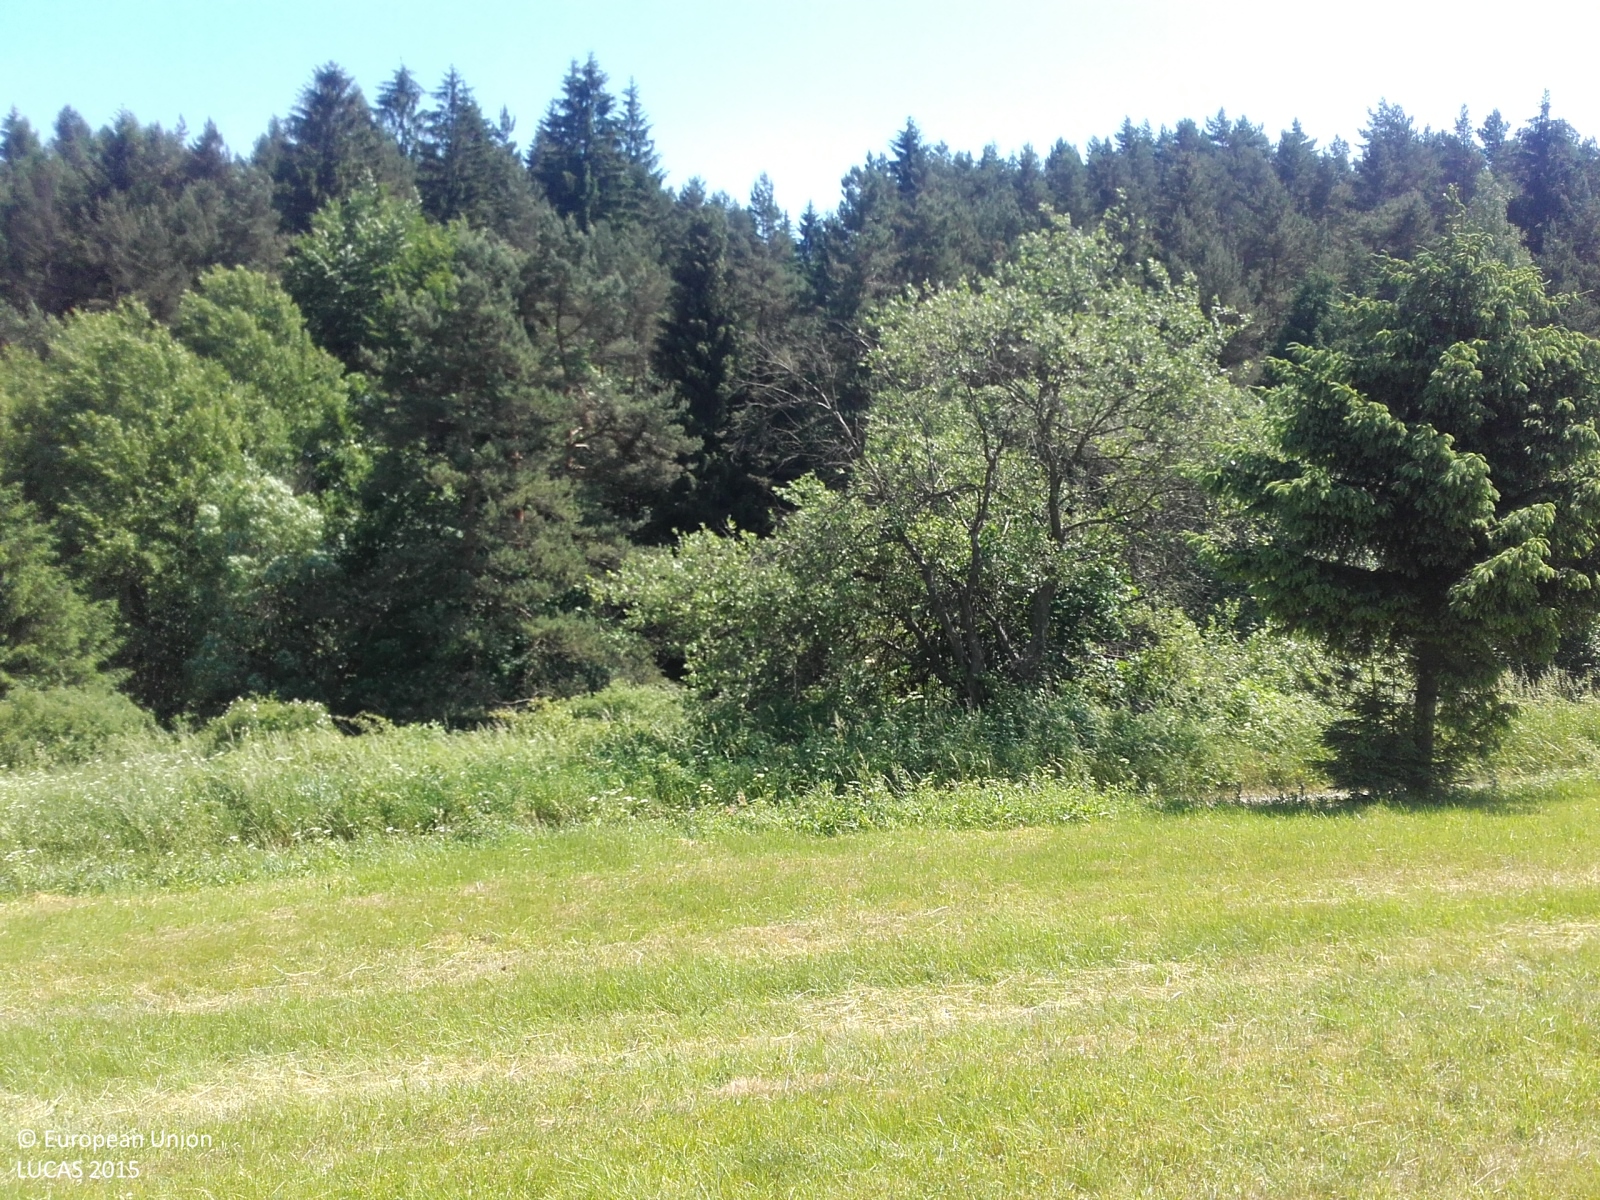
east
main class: Grassland
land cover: Grassland without tree/shrub cover
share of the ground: > 75 %
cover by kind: herbaceous plants 100 %
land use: Agriculture (excluding fallow land and kitchen gardens)
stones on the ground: < 10 %
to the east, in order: Grassland without tree/shrub cover; Tracks; Shrubland with sparse tree cover; Spontaneously vegetated surfaces; Rivers and streams; Spruce dominated mixed woodland; Spruce dominated coniferous woodland
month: June
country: CZ
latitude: 49.5384
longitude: 18.7678
